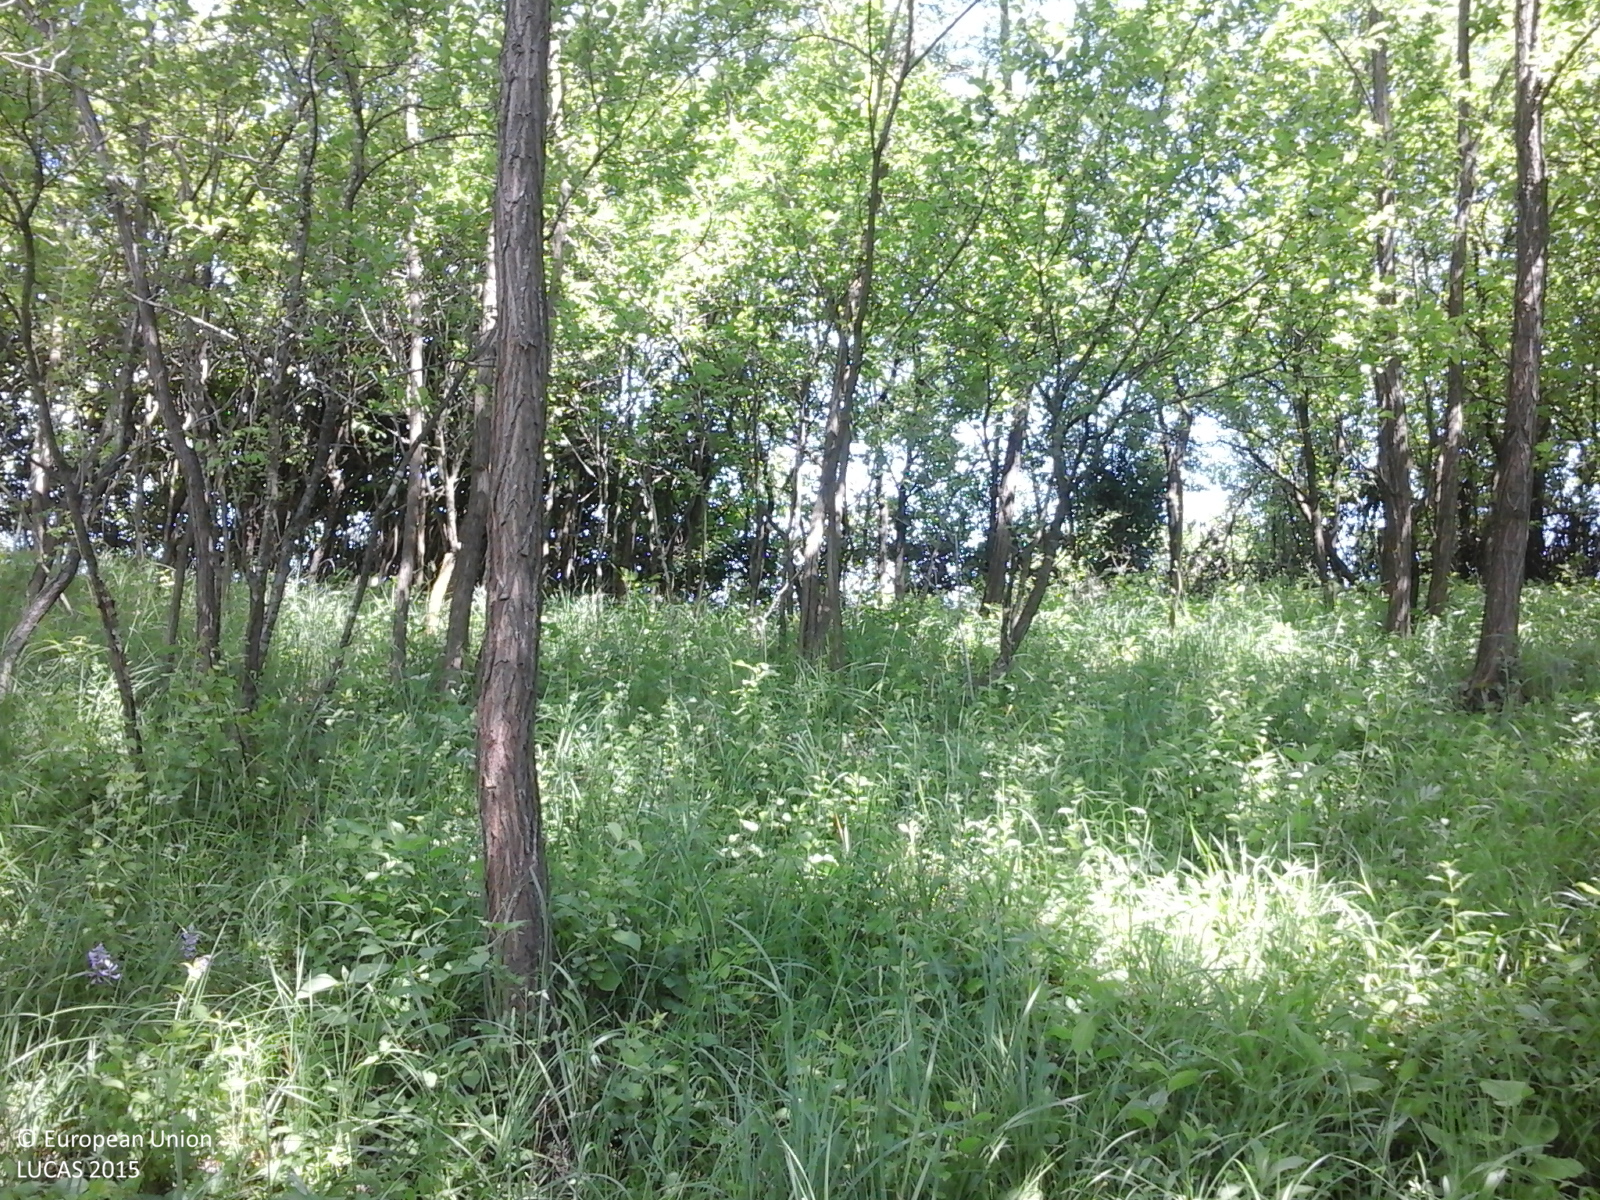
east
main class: Cropland
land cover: Other fruit trees and berries
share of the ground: 50 - 75 %
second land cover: Grassland without tree/shrub cover
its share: > 75 %
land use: Agriculture (excluding fallow land and kitchen gardens)
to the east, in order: Other fruit trees and berries; Grassland without tree/shrub cover; Fences; Single bushes/trees; Fences; Broadleaved woodland; Apple fruit; Broadleaved woodland; Lines of trees; Nuts trees; Broadleaved woodland
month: May
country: RO
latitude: 45.1500
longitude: 26.1521
